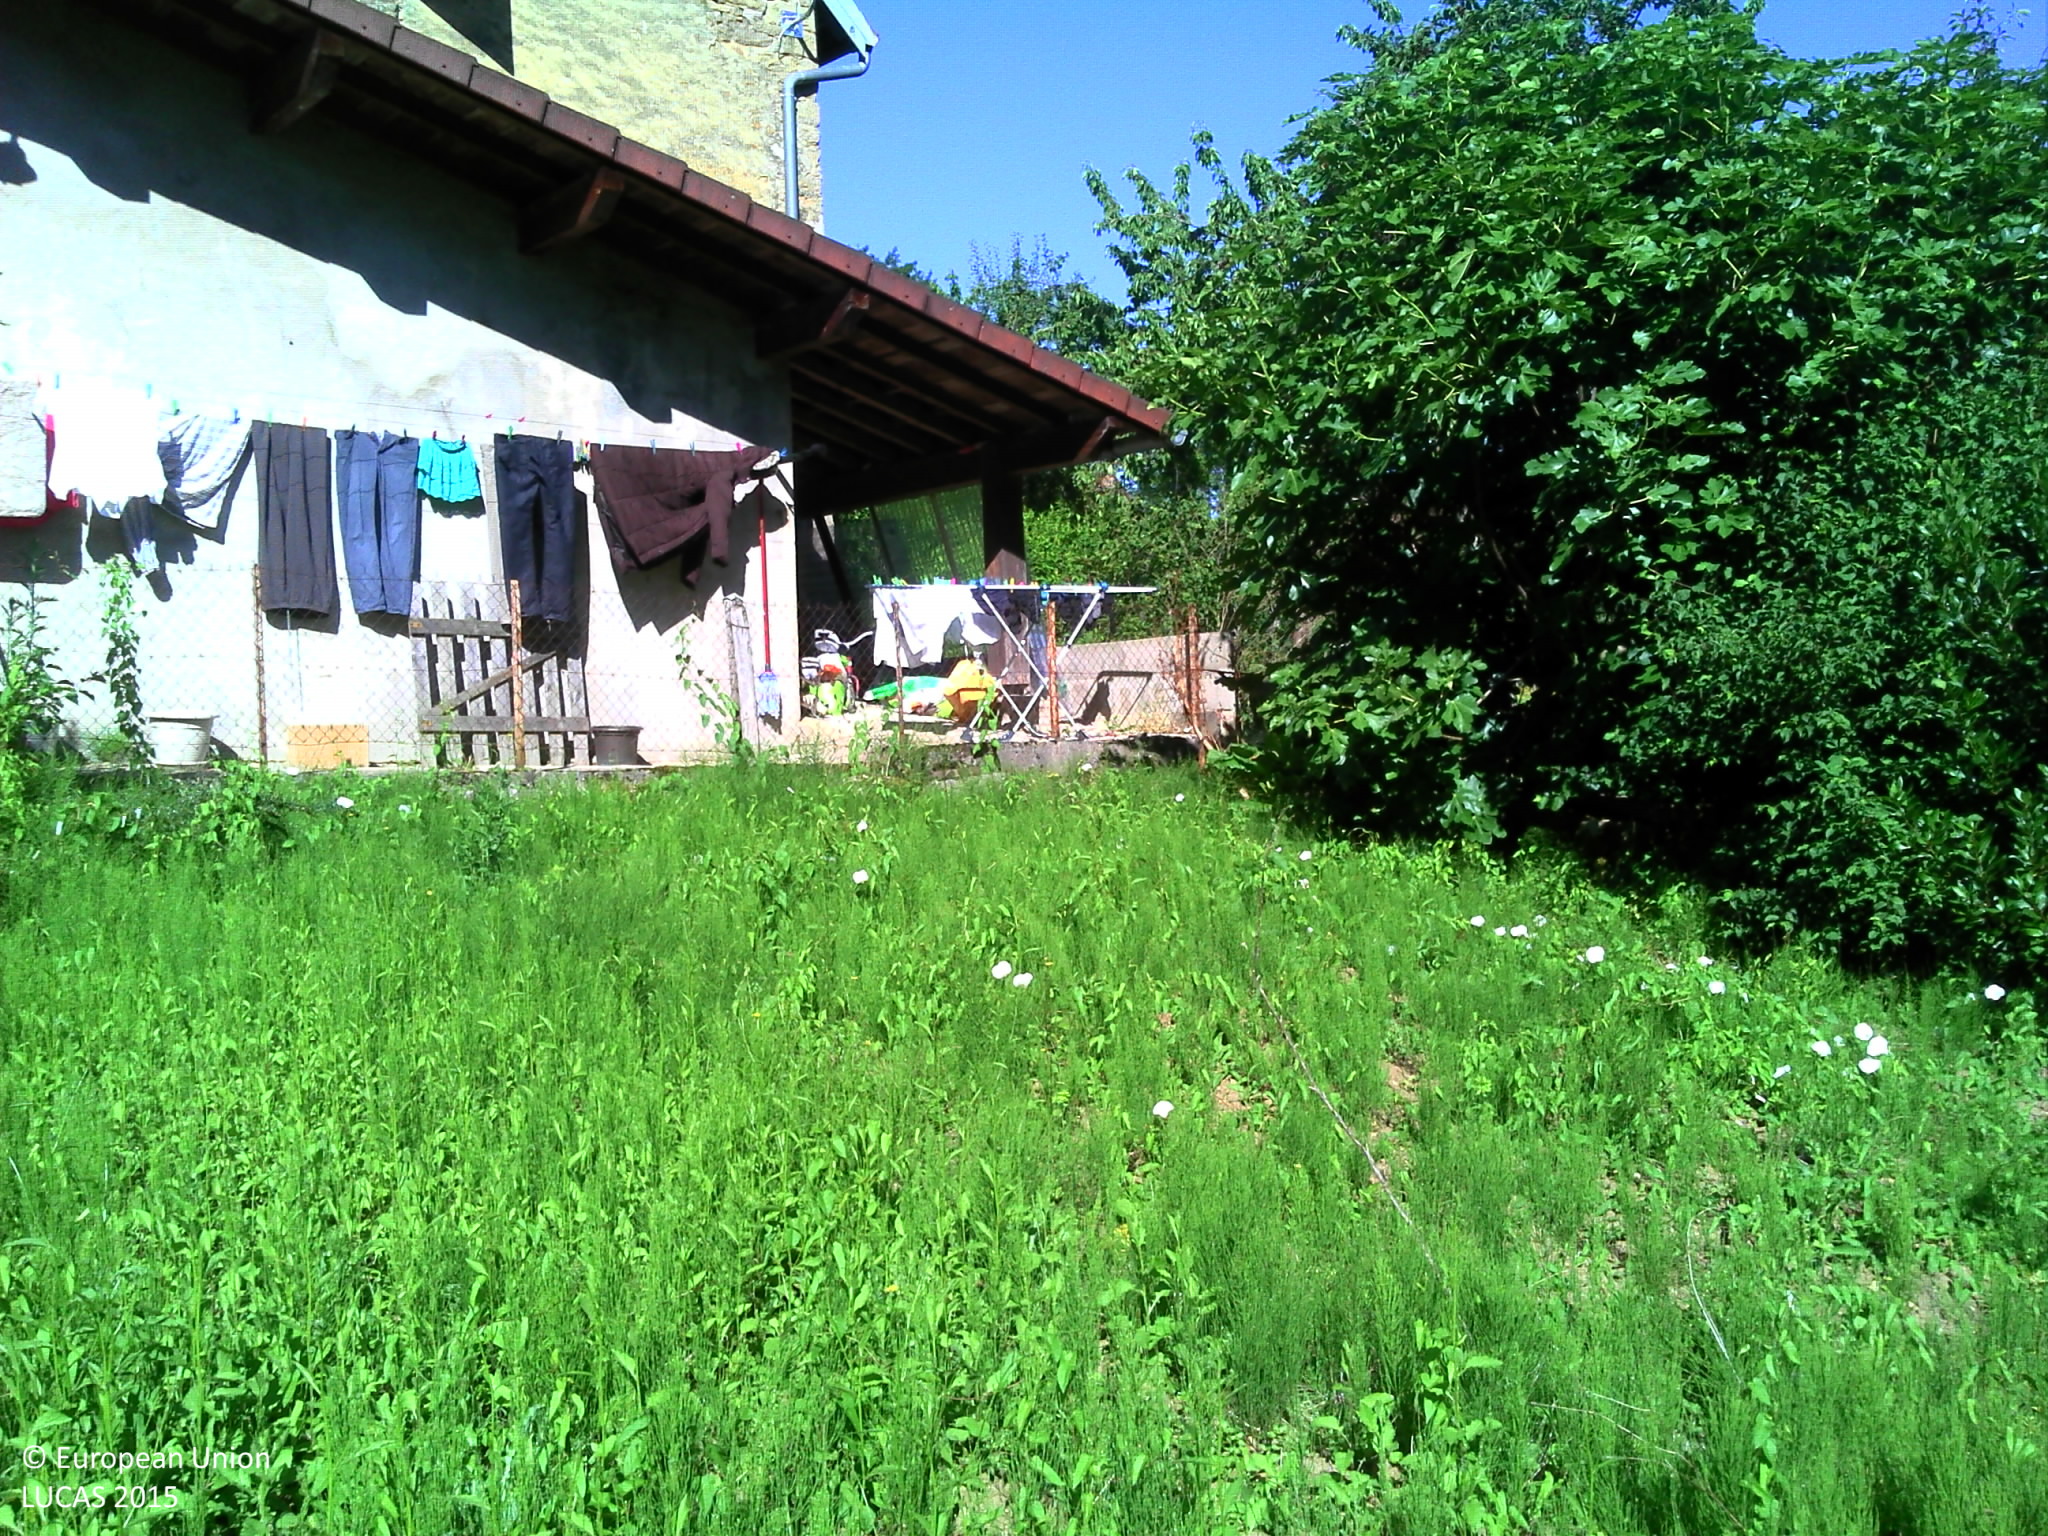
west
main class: Grassland
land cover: Spontaneously vegetated surfaces
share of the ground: > 75 %
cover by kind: herbaceous plants 100 %
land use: Residential
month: June
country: FR
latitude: 46.5600
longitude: 5.4238
